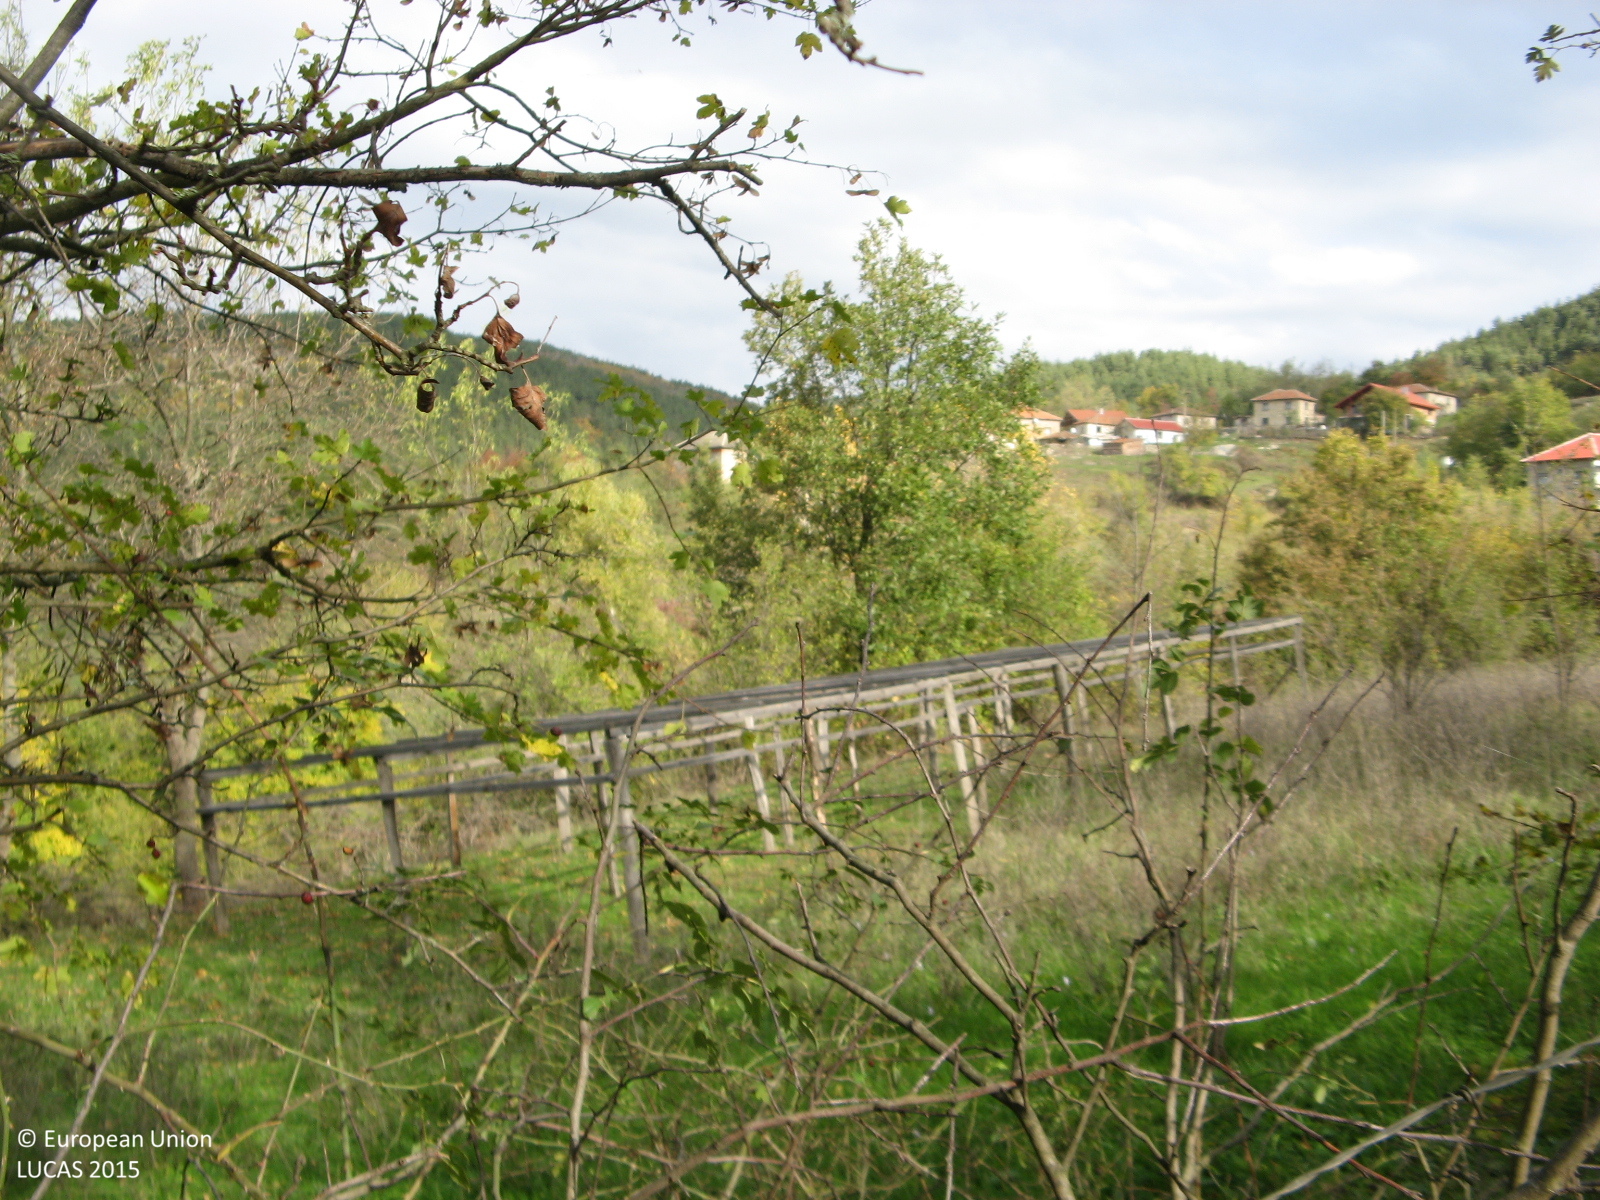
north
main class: Grassland
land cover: Grassland with sparse tree/shrub cover
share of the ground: > 75 %
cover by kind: herbaceous plants 85 %, shrubs 10 %, broadleaved forest trees 5 %
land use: Agriculture (excluding fallow land and kitchen gardens)
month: November
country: BG
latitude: 41.3954
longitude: 25.2773
